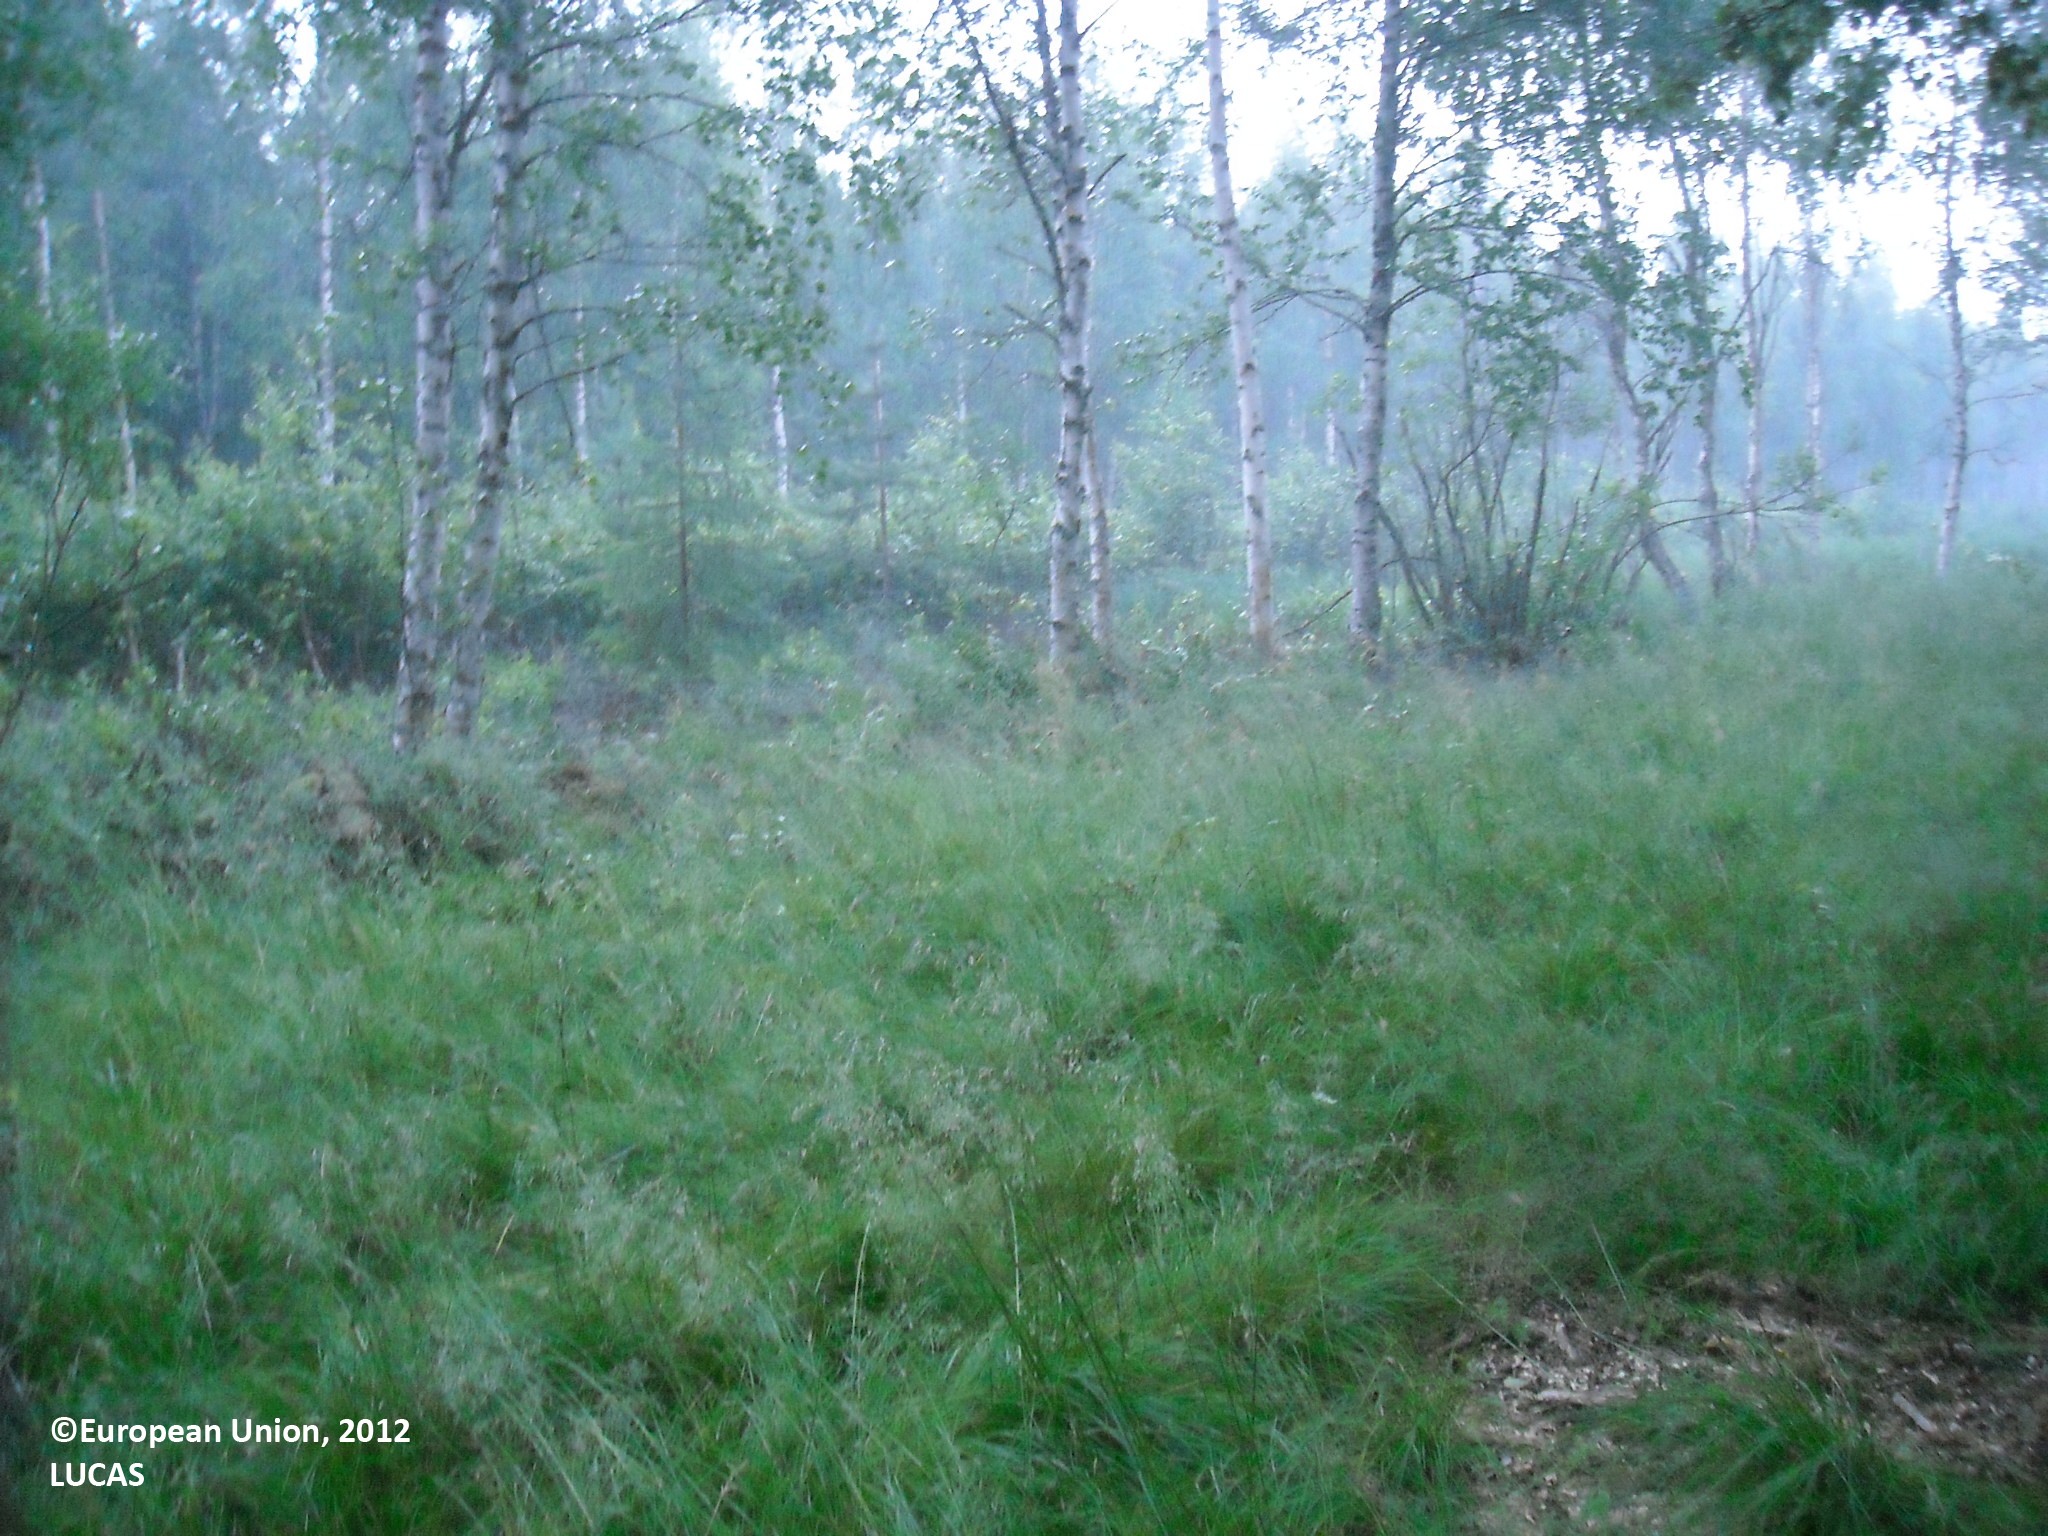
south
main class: Woodland
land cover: Broadleaved woodland
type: boreal forest
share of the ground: 50 - 75 %
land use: Forestry
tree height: > 5 m
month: July
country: FI
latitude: 64.8567
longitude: 26.7166
